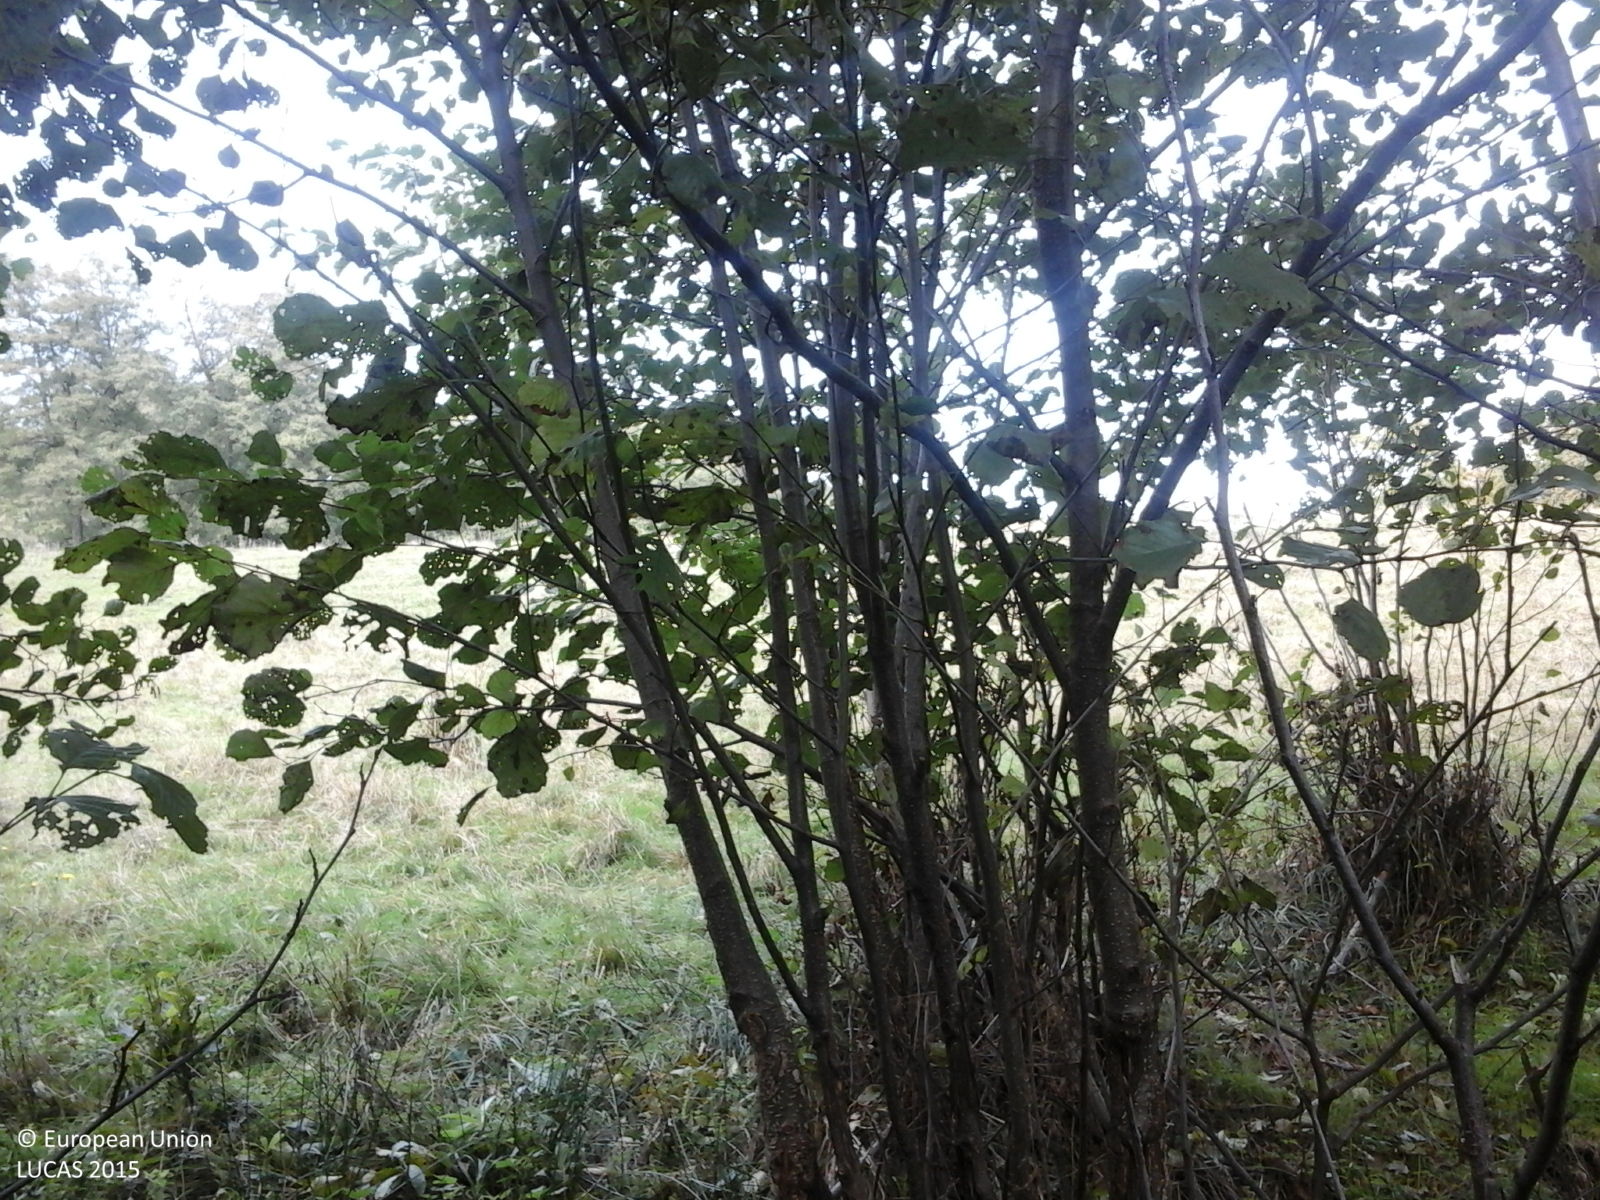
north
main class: Woodland
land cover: Broadleaved woodland
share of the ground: > 75 %
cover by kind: broadleaved forest trees 100 %
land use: Forestry
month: October
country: RO
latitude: 46.3046
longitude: 25.1741
